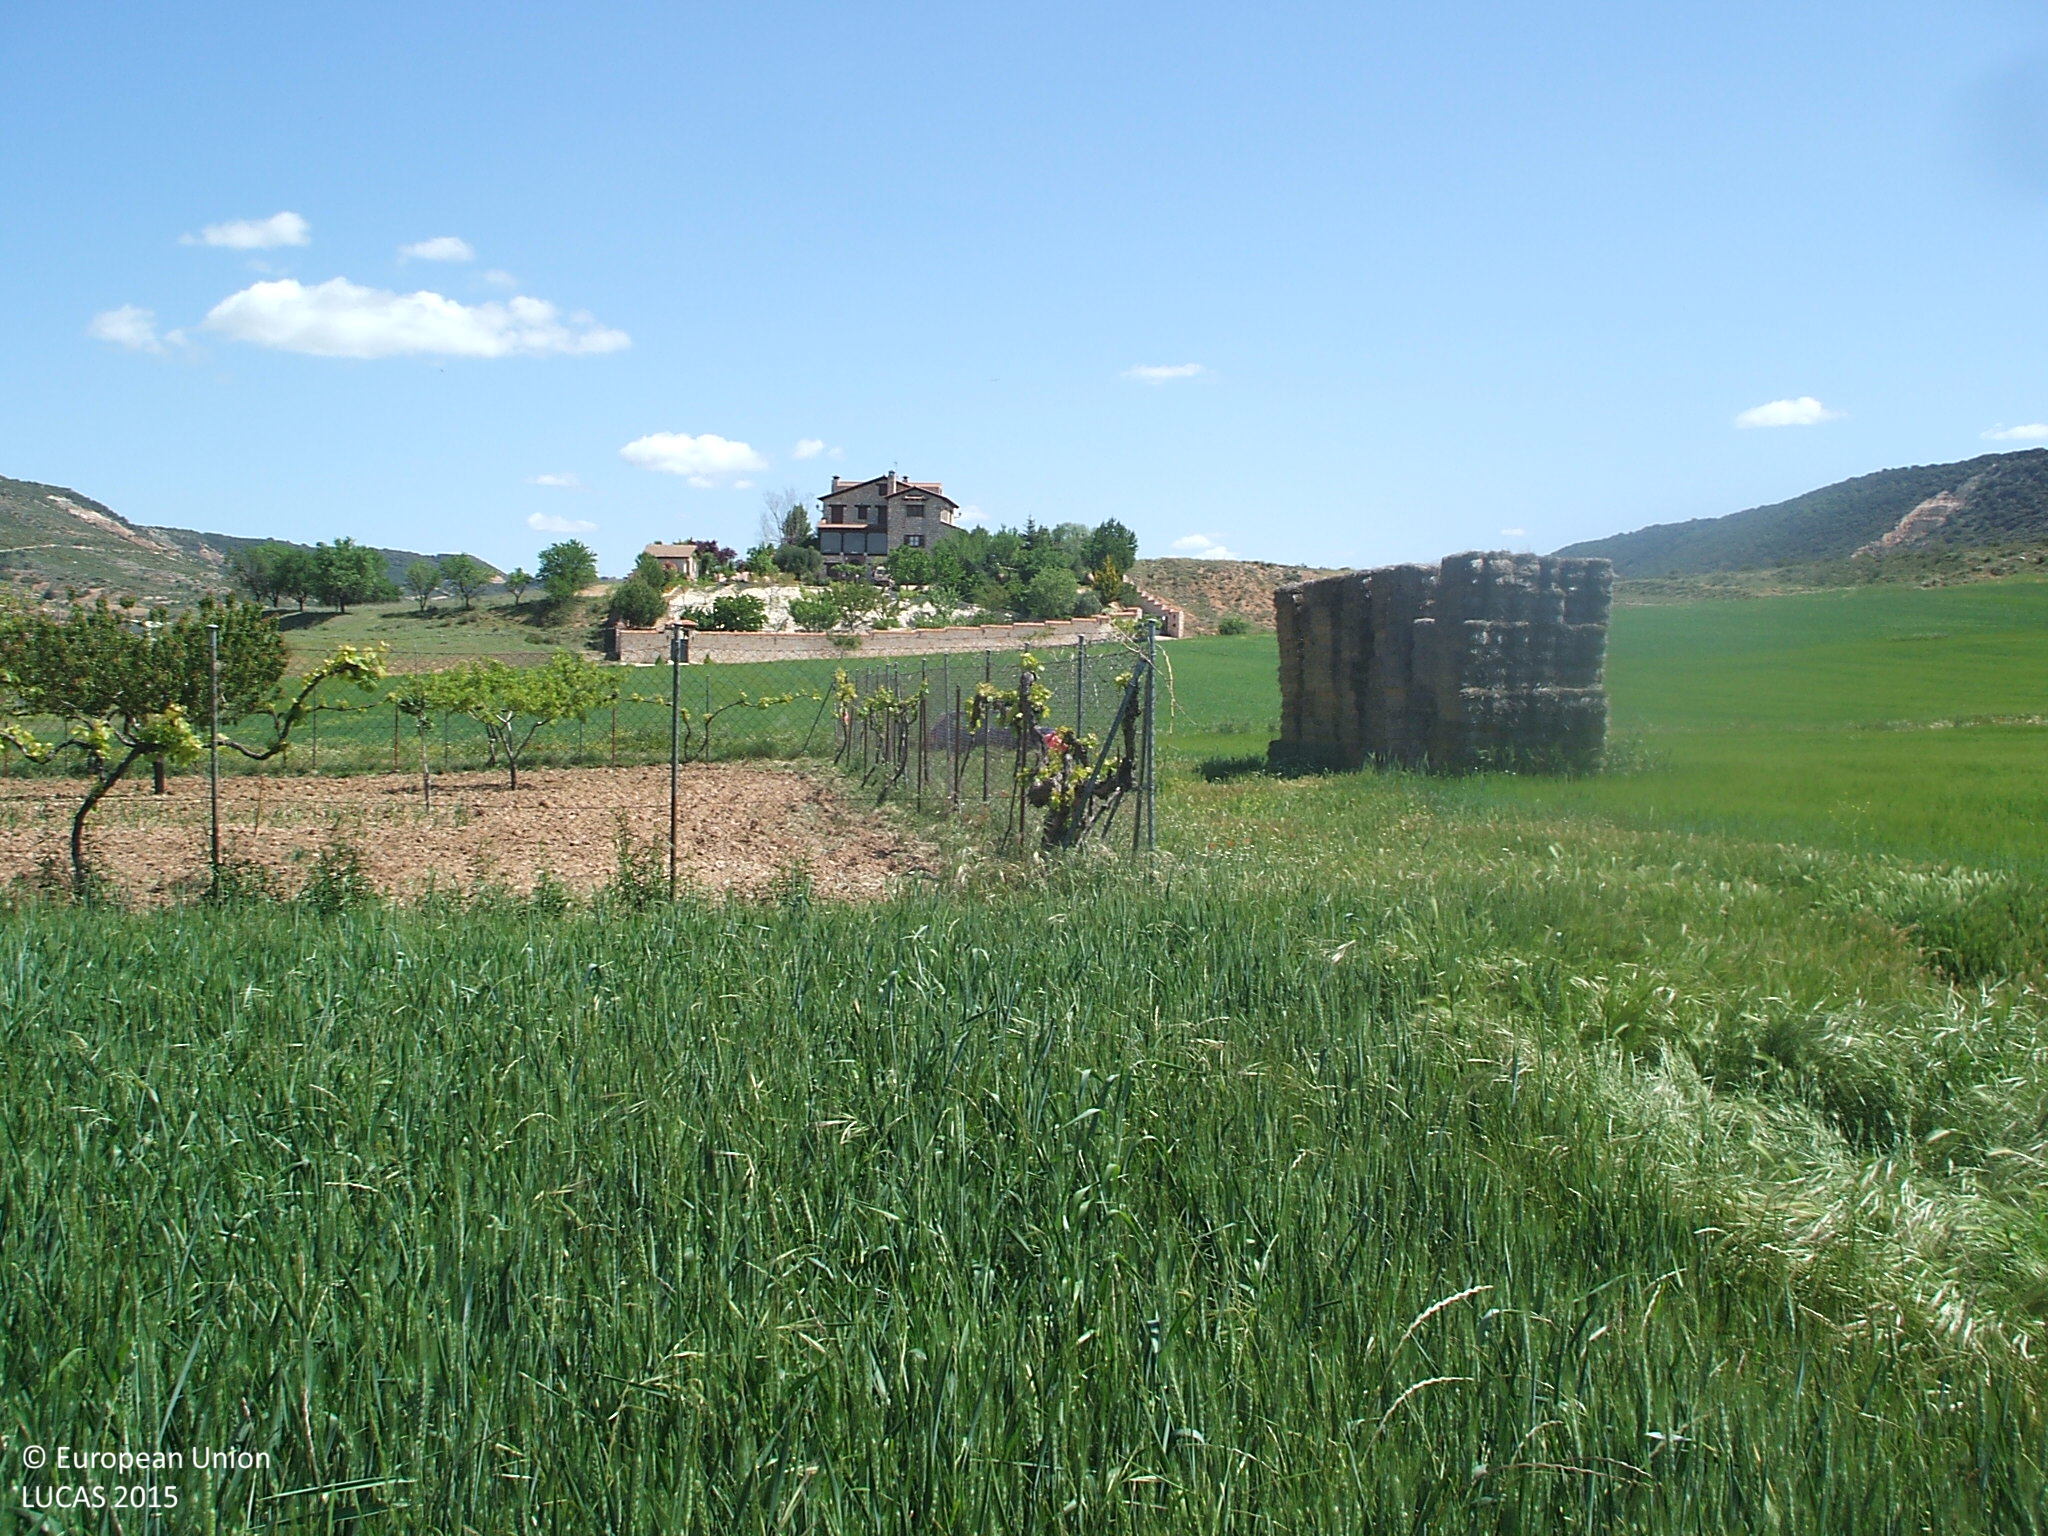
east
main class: Cropland
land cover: Common wheat
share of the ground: > 75 %
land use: Agriculture (excluding fallow land and kitchen gardens)
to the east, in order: Common wheat; Tracks; Barley; Tracks; Barley
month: May
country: ES
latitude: 40.8083
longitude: -2.9901
